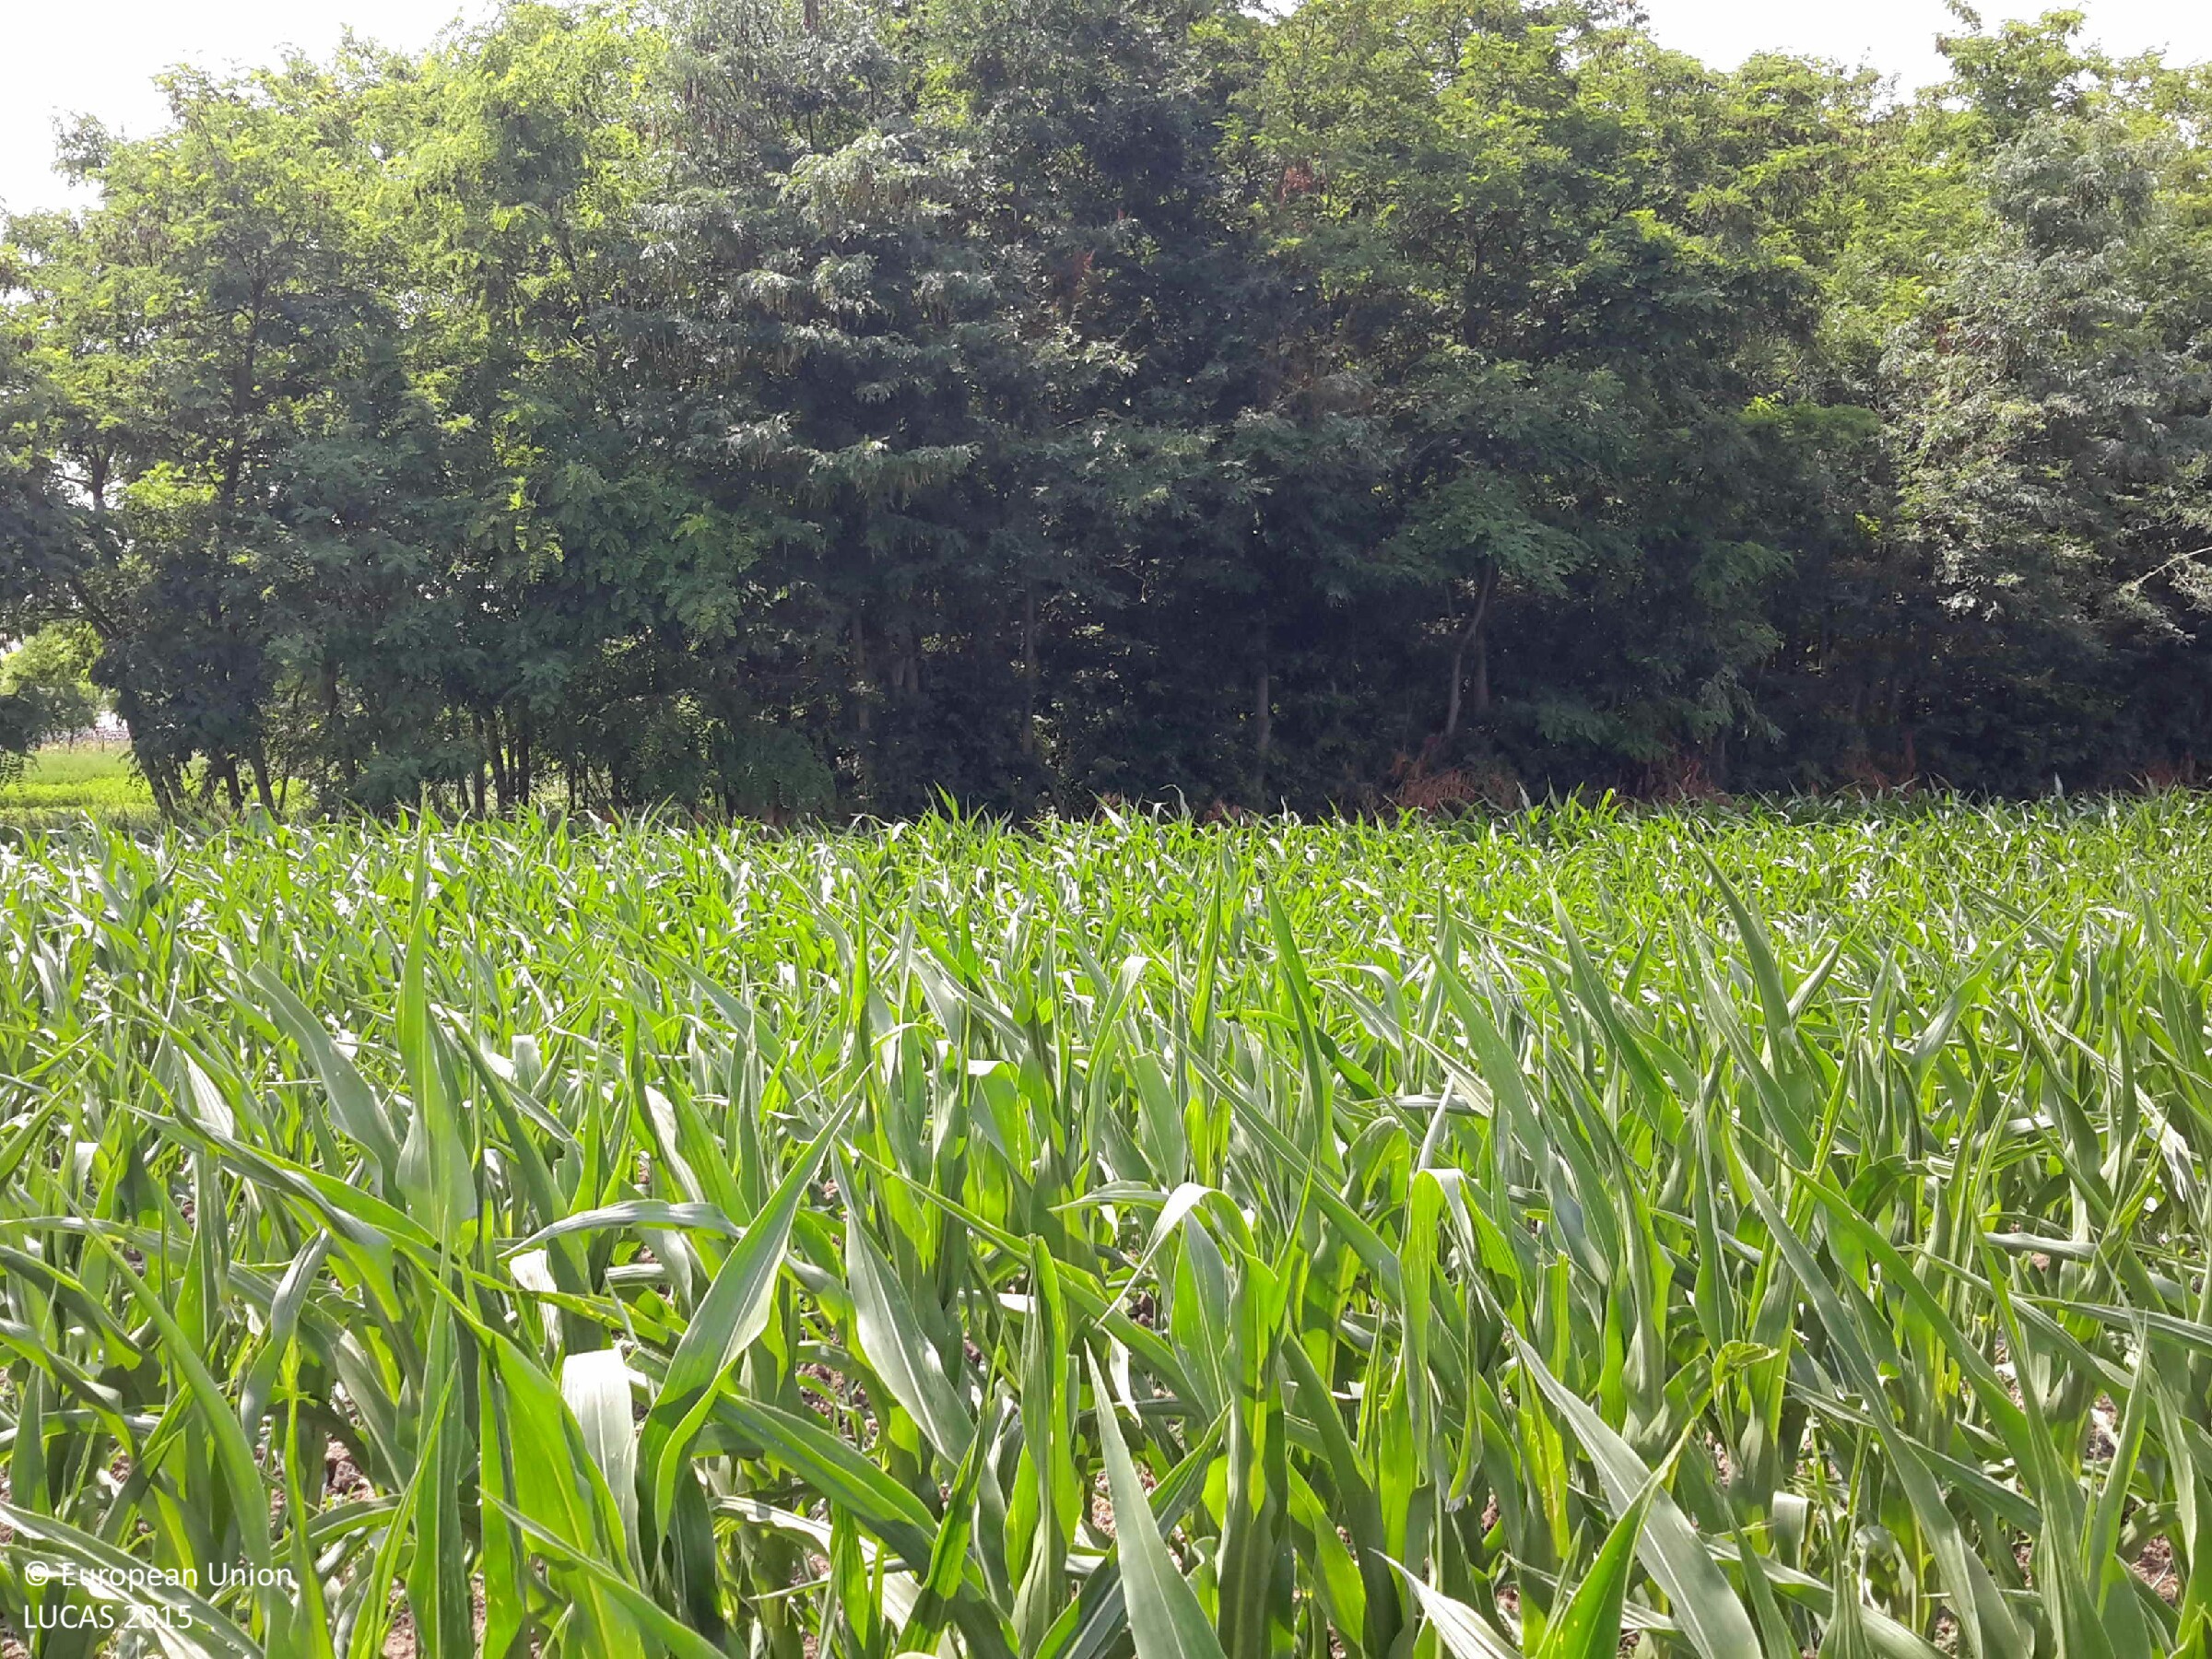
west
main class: Cropland
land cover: Maize
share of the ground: 50 - 75 %
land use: Agriculture (excluding fallow land and kitchen gardens)
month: July
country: HU
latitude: 47.3615
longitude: 17.3820
